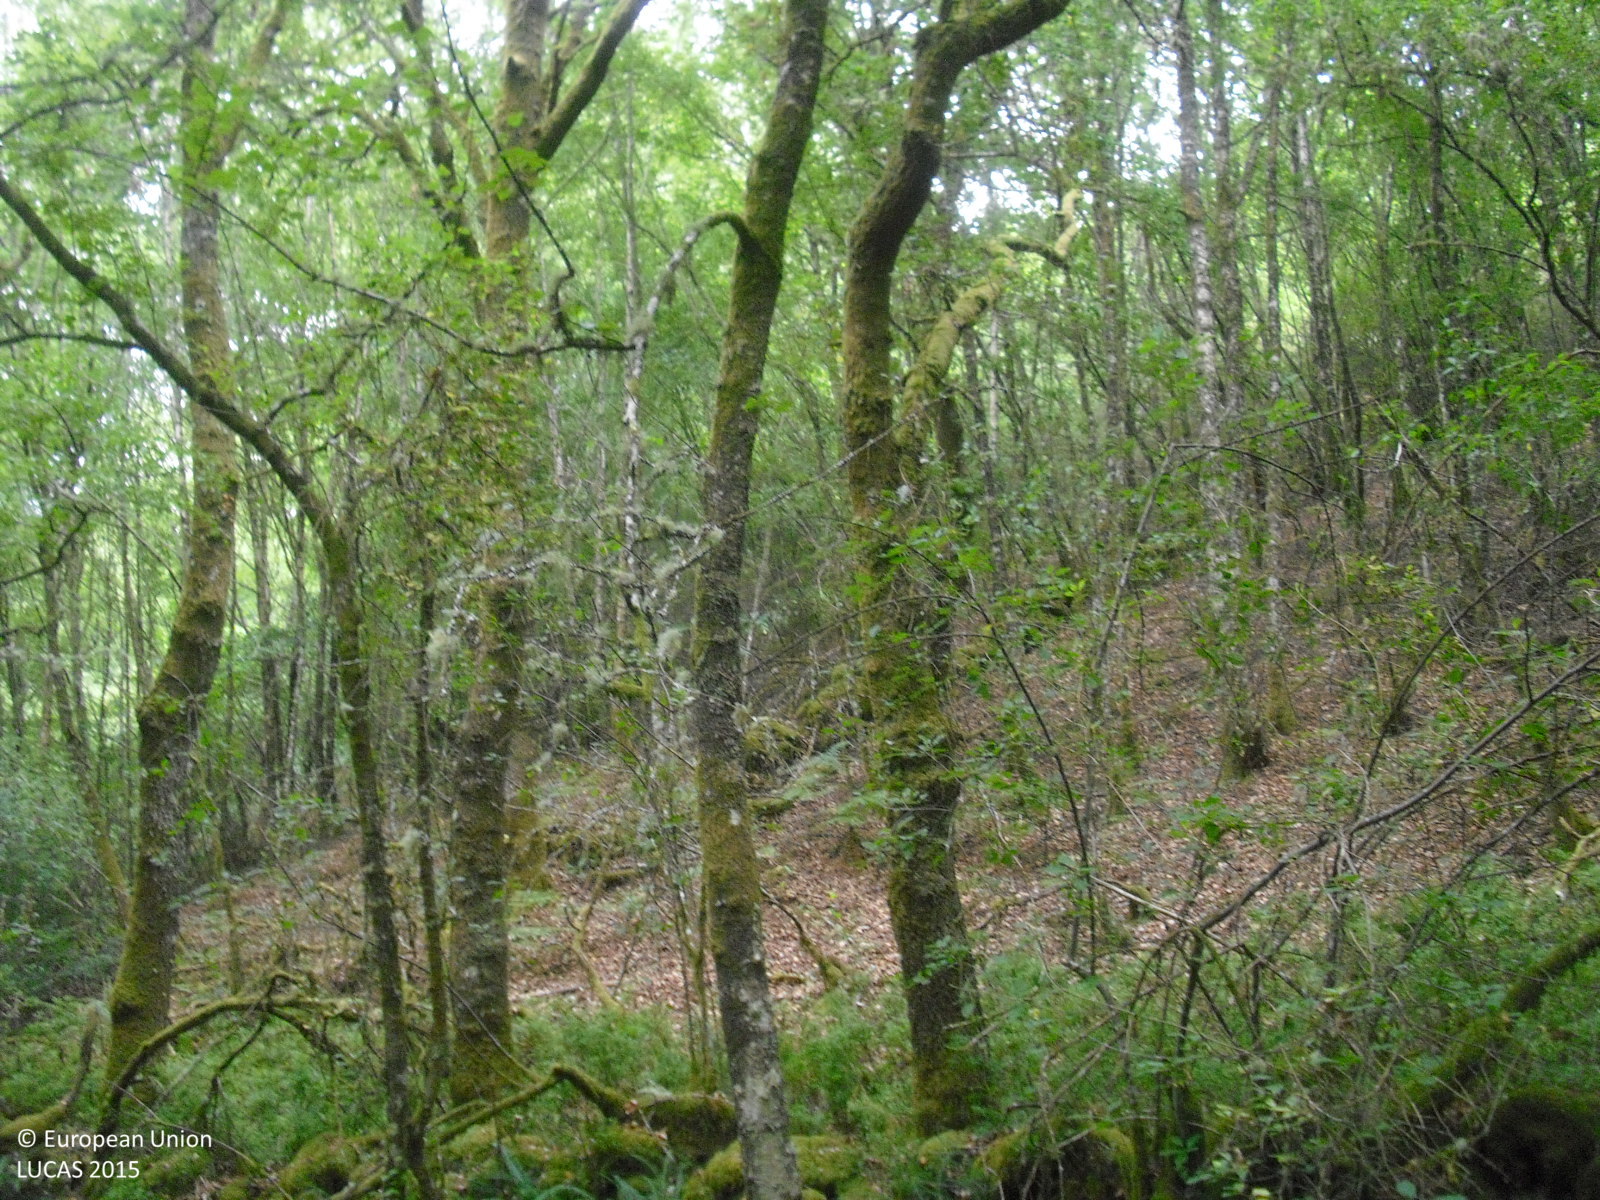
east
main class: Woodland
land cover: Broadleaved woodland
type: thermophilous deciduous forest
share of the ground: > 75 %
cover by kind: broadleaved forest trees 90 %, shrubs 10 %
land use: Semi-natural and natural areas not in use
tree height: > 5 m
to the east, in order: Broadleaved woodland; Rivers and streams; Broadleaved woodland; Dry stone walls; Broadleaved woodland; Dry stone walls; Broadleaved woodland; Tracks; Broadleaved woodland; Tracks; Shruby margins; Tracks; Ditches and canals; Shrubland with sparse tree cover; Broadleaved woodland
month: July
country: ES
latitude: 42.3811
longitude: -7.6462
